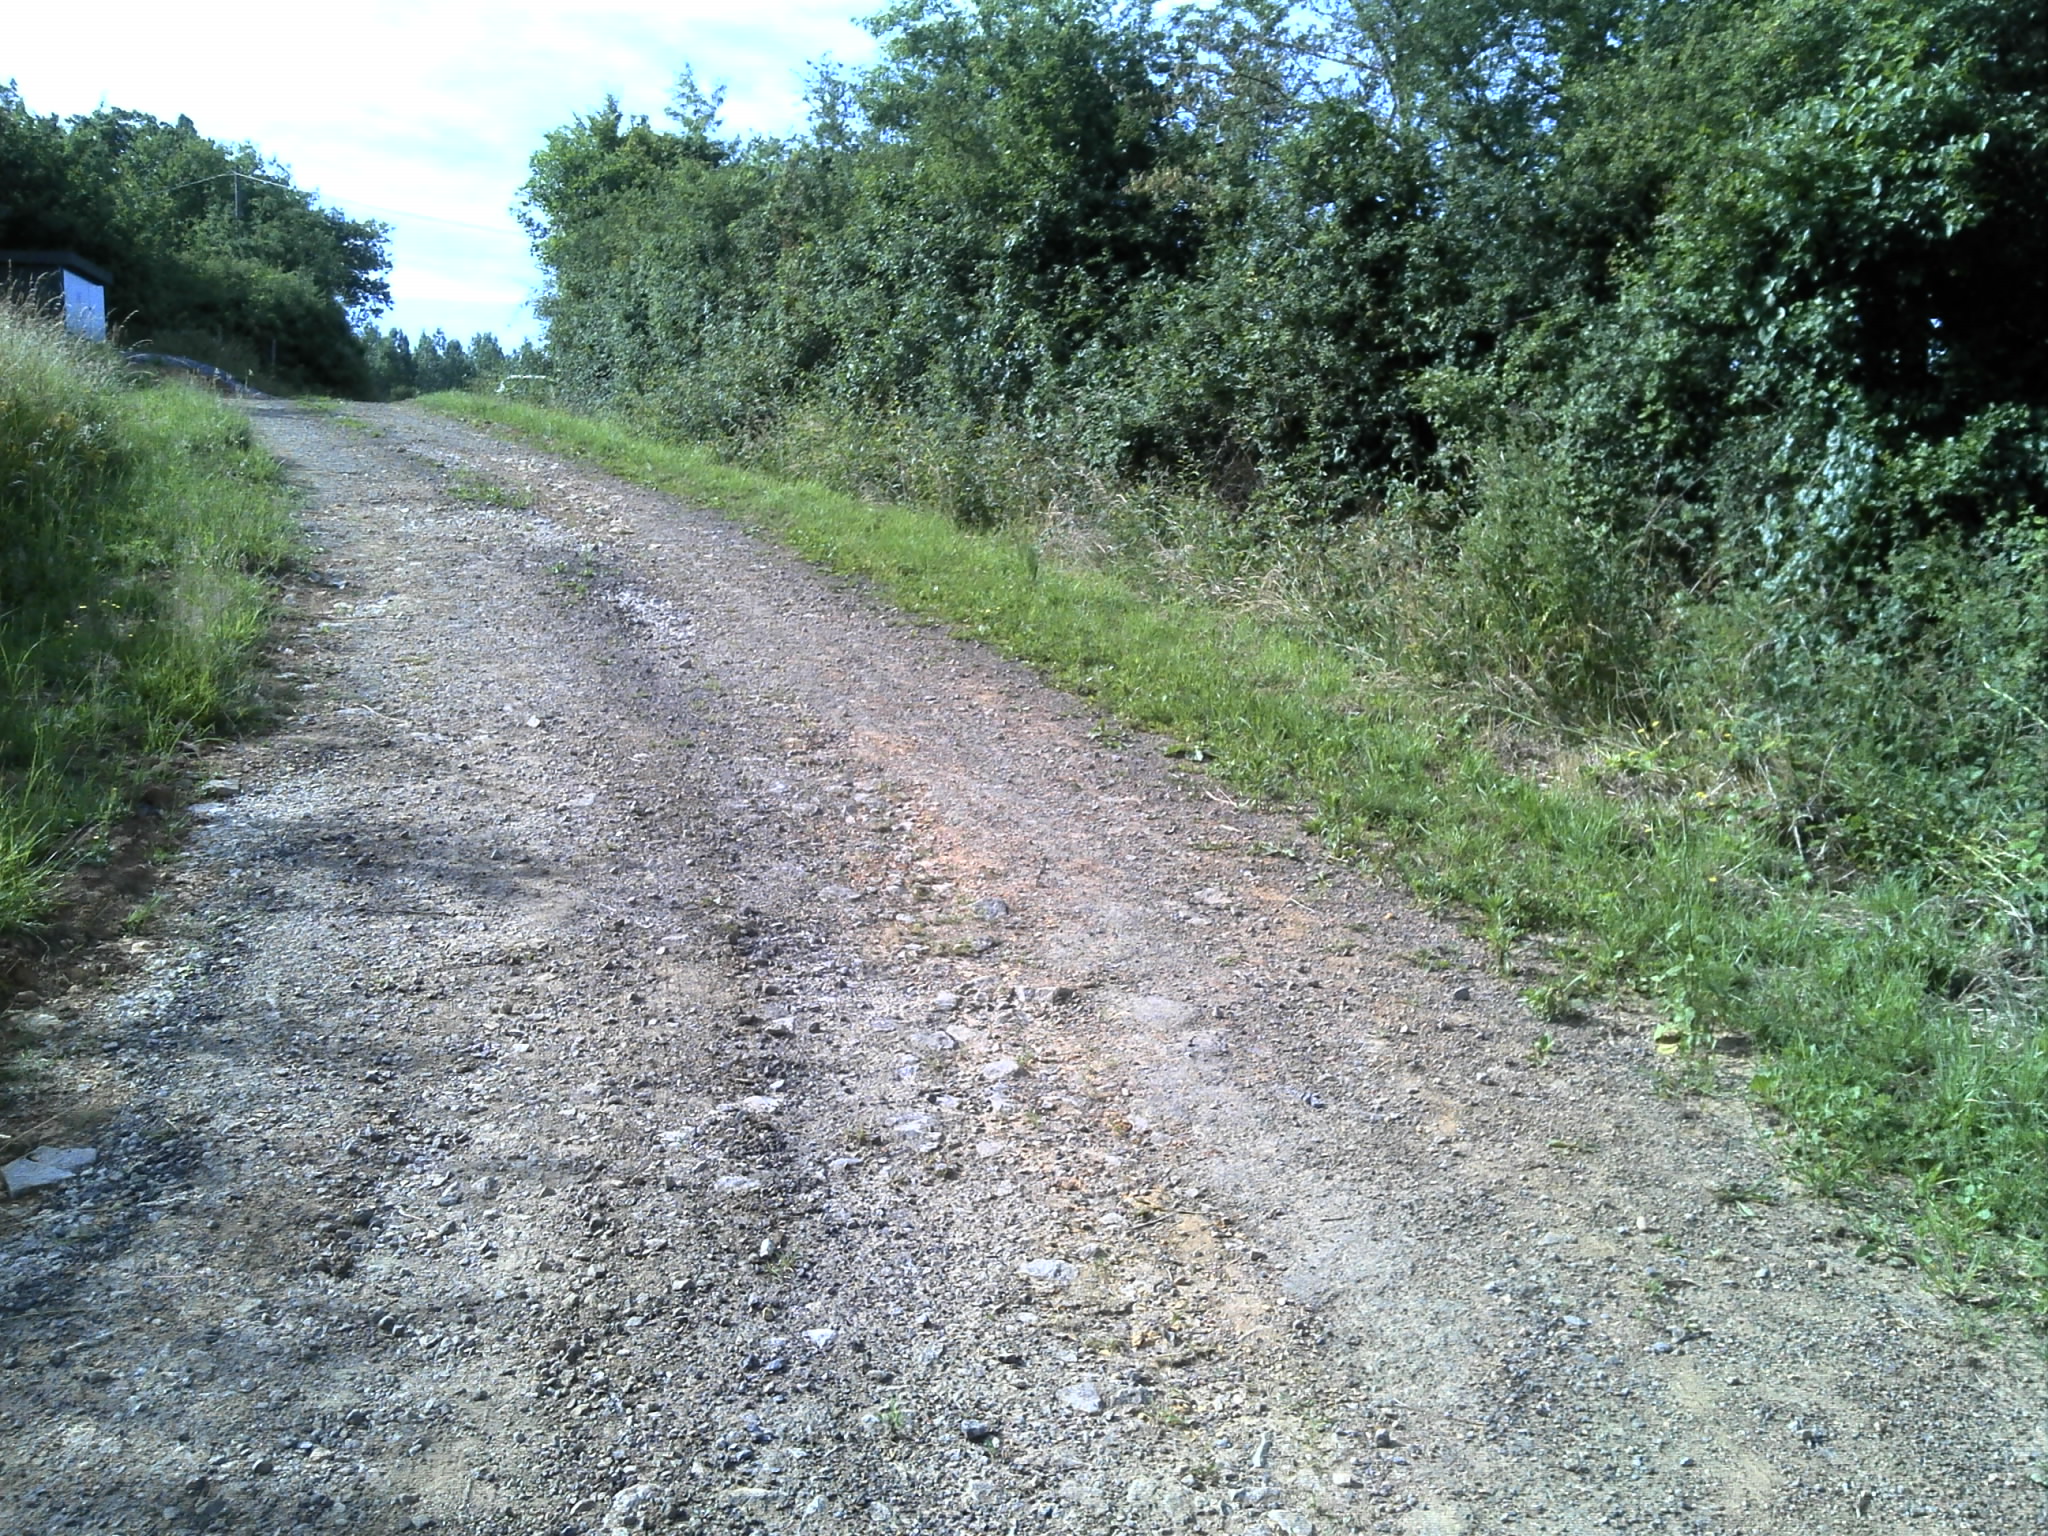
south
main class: Woodland
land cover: Broadleaved woodland
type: mesophytic deciduous forest
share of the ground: > 75 %
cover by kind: broadleaved forest trees 50 %, shrubs 50 %
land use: Semi-natural and natural areas not in use
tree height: < 5 m
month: June
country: FR
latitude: 46.5575
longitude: 1.5241
